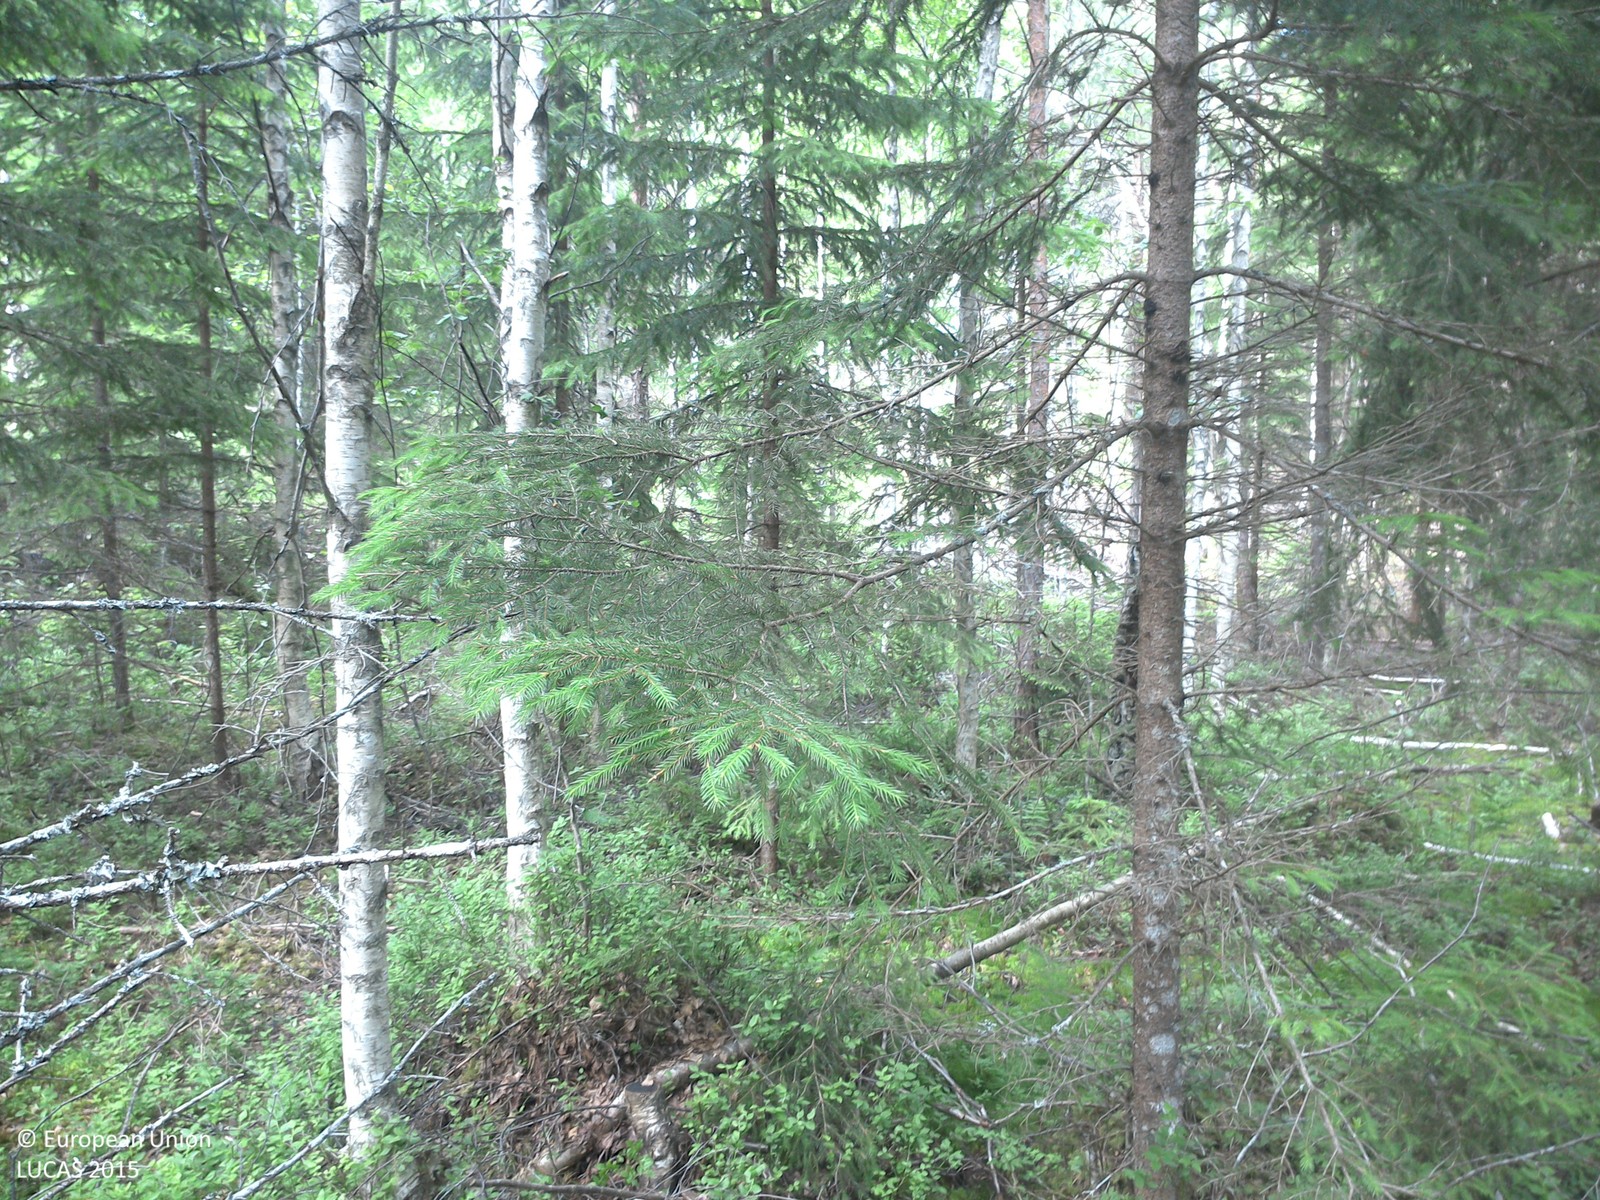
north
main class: Woodland
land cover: Spruce dominated mixed woodland
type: boreal forest
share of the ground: > 75 %
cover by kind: coniferous forest trees 60 %, broadleaved forest trees 20 %, herbaceous plants 20 %
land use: Forestry
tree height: > 5 m
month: June
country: SE
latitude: 58.0500
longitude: 15.5697
